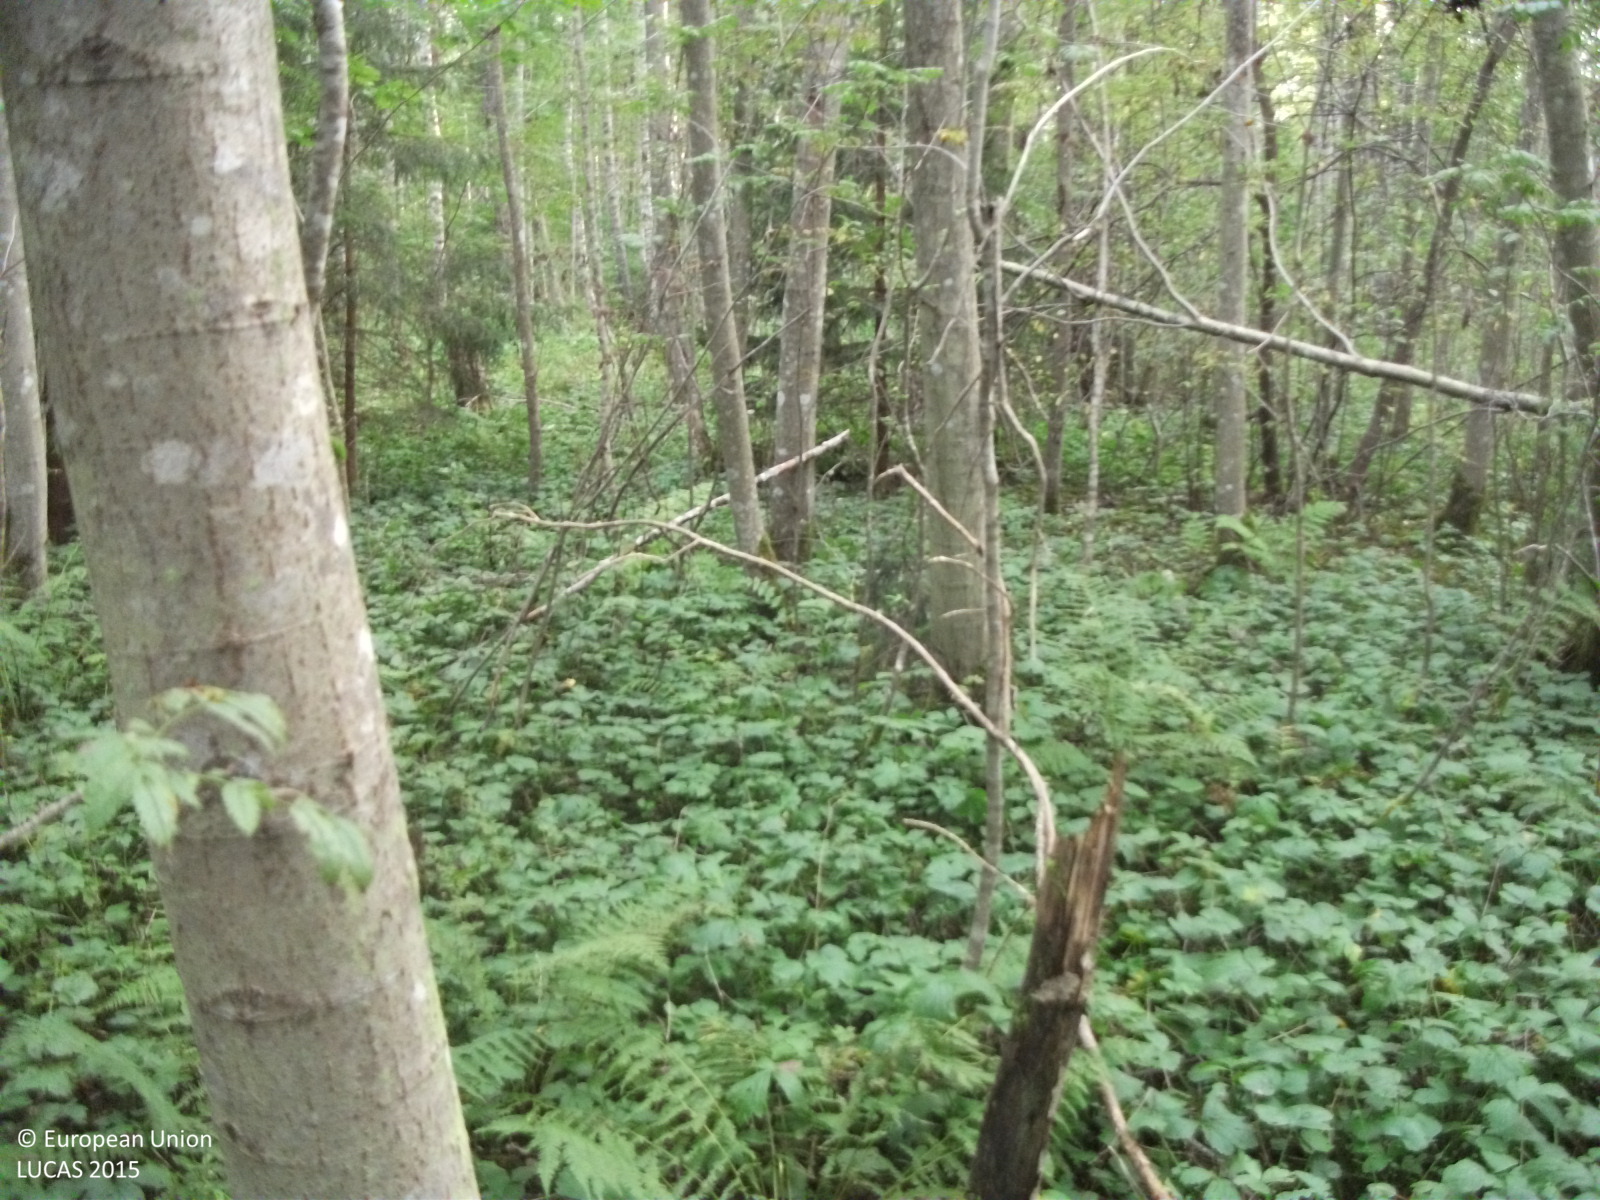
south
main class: Woodland
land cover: Broadleaved woodland
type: non-riverine alder, birch or aspen forest
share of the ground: > 75 %
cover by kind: broadleaved forest trees 85 %, herbaceous plants 10 %, coniferous forest trees 5 %
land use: Forestry
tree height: > 5 m
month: September
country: LV
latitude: 57.5926
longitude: 24.4946
